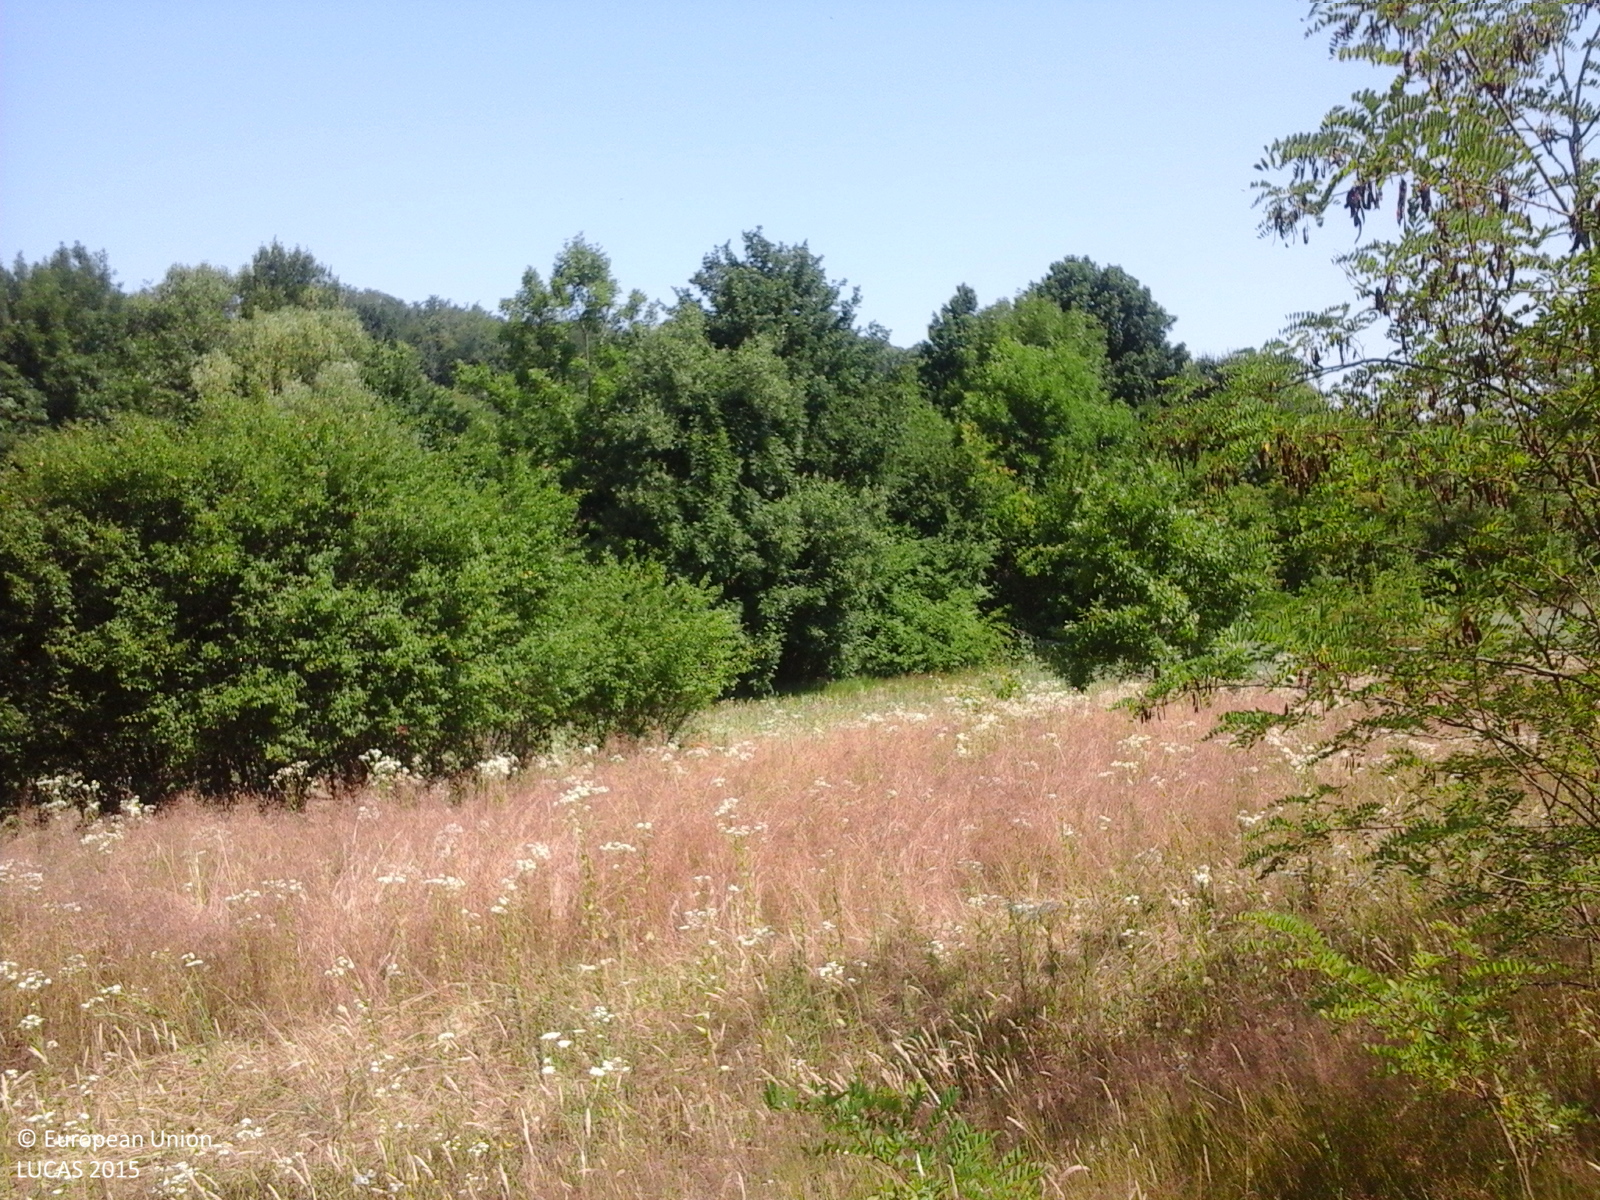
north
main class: Woodland
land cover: Broadleaved woodland
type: thermophilous deciduous forest
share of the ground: > 75 %
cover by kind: broadleaved forest trees 100 %
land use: Forestry
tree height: > 5 m
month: July
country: RO
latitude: 44.8397
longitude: 24.5344
